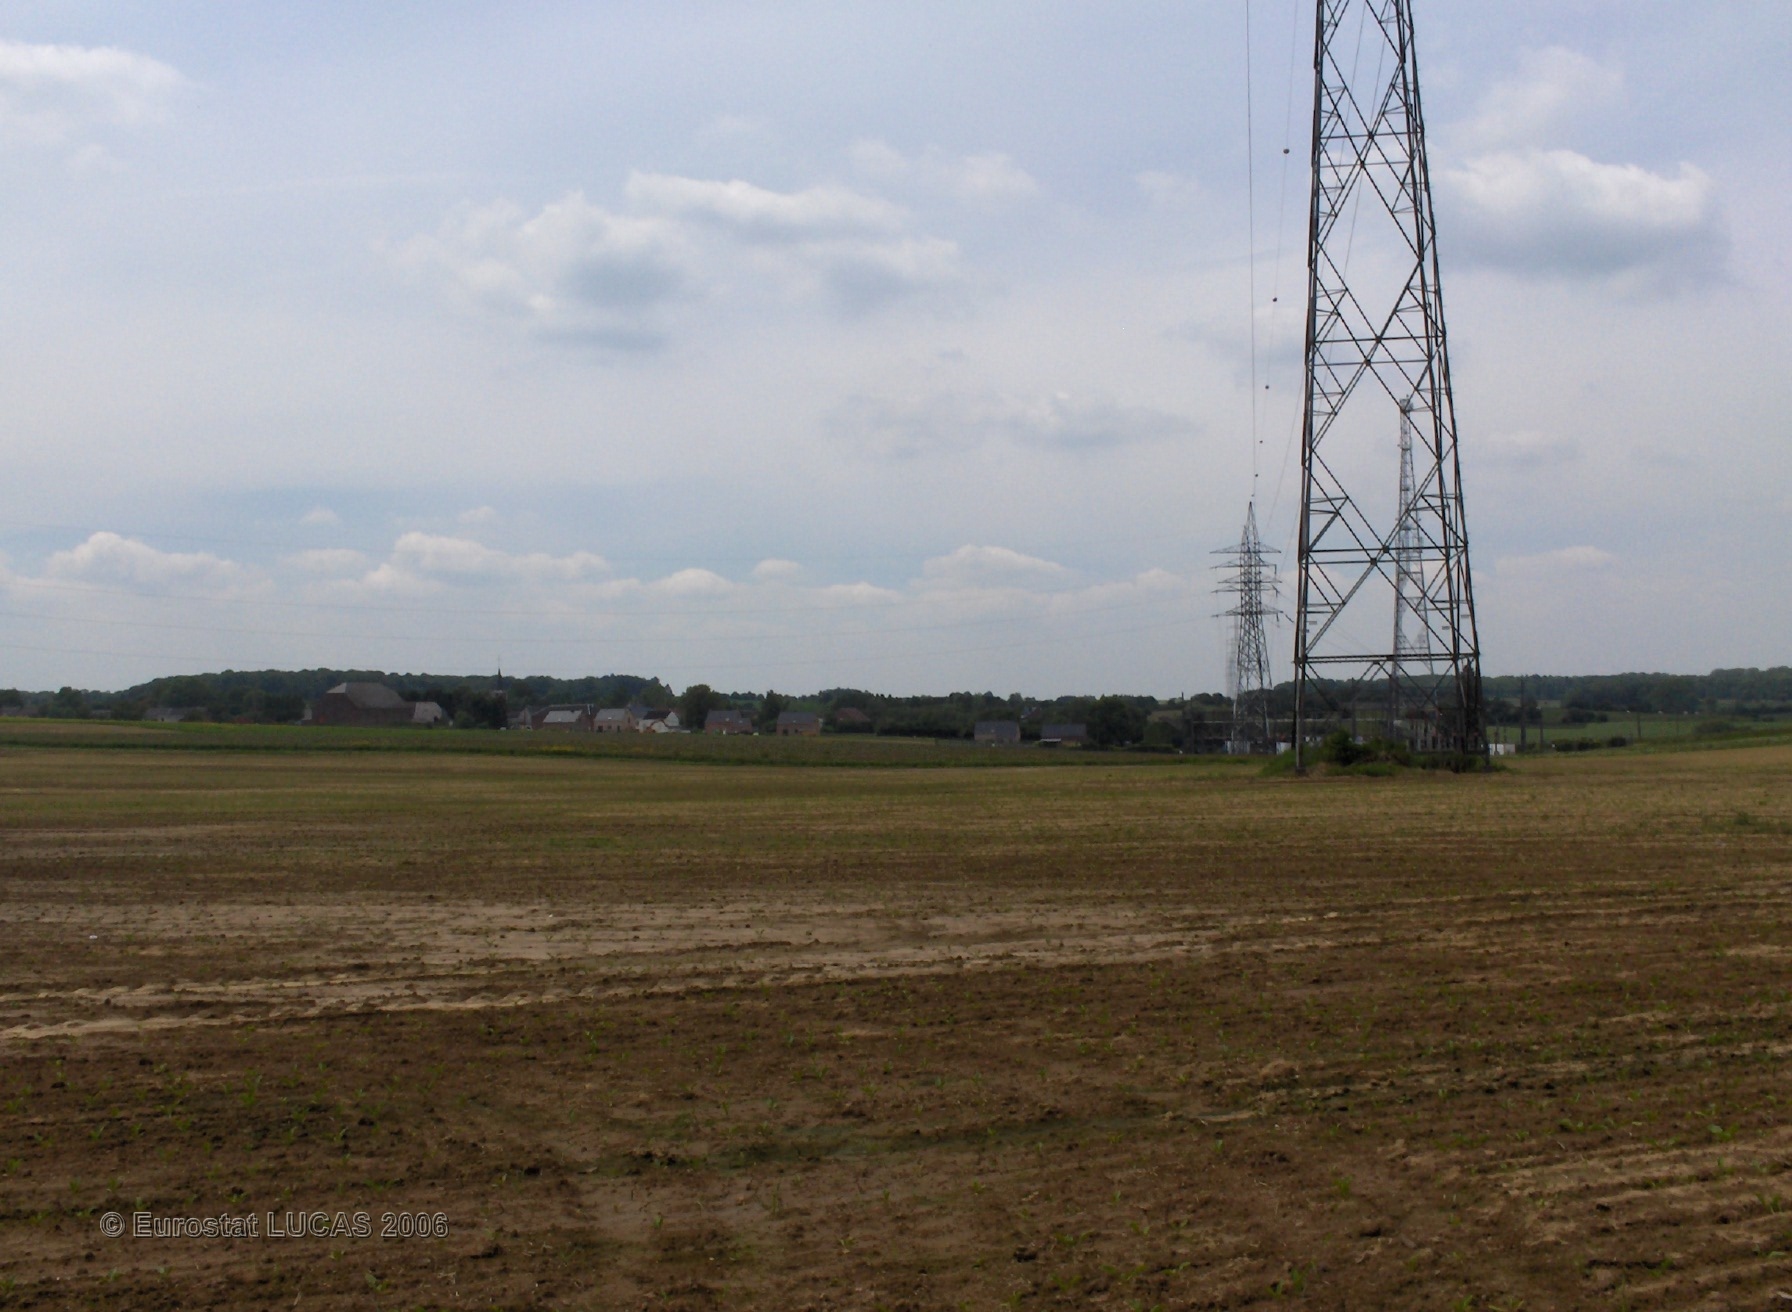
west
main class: Grassland
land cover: Grassland without tree/shrub cover
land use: Agriculture (excluding fallow land and kitchen gardens)
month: June
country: BE
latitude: 50.2146
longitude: 4.5166
